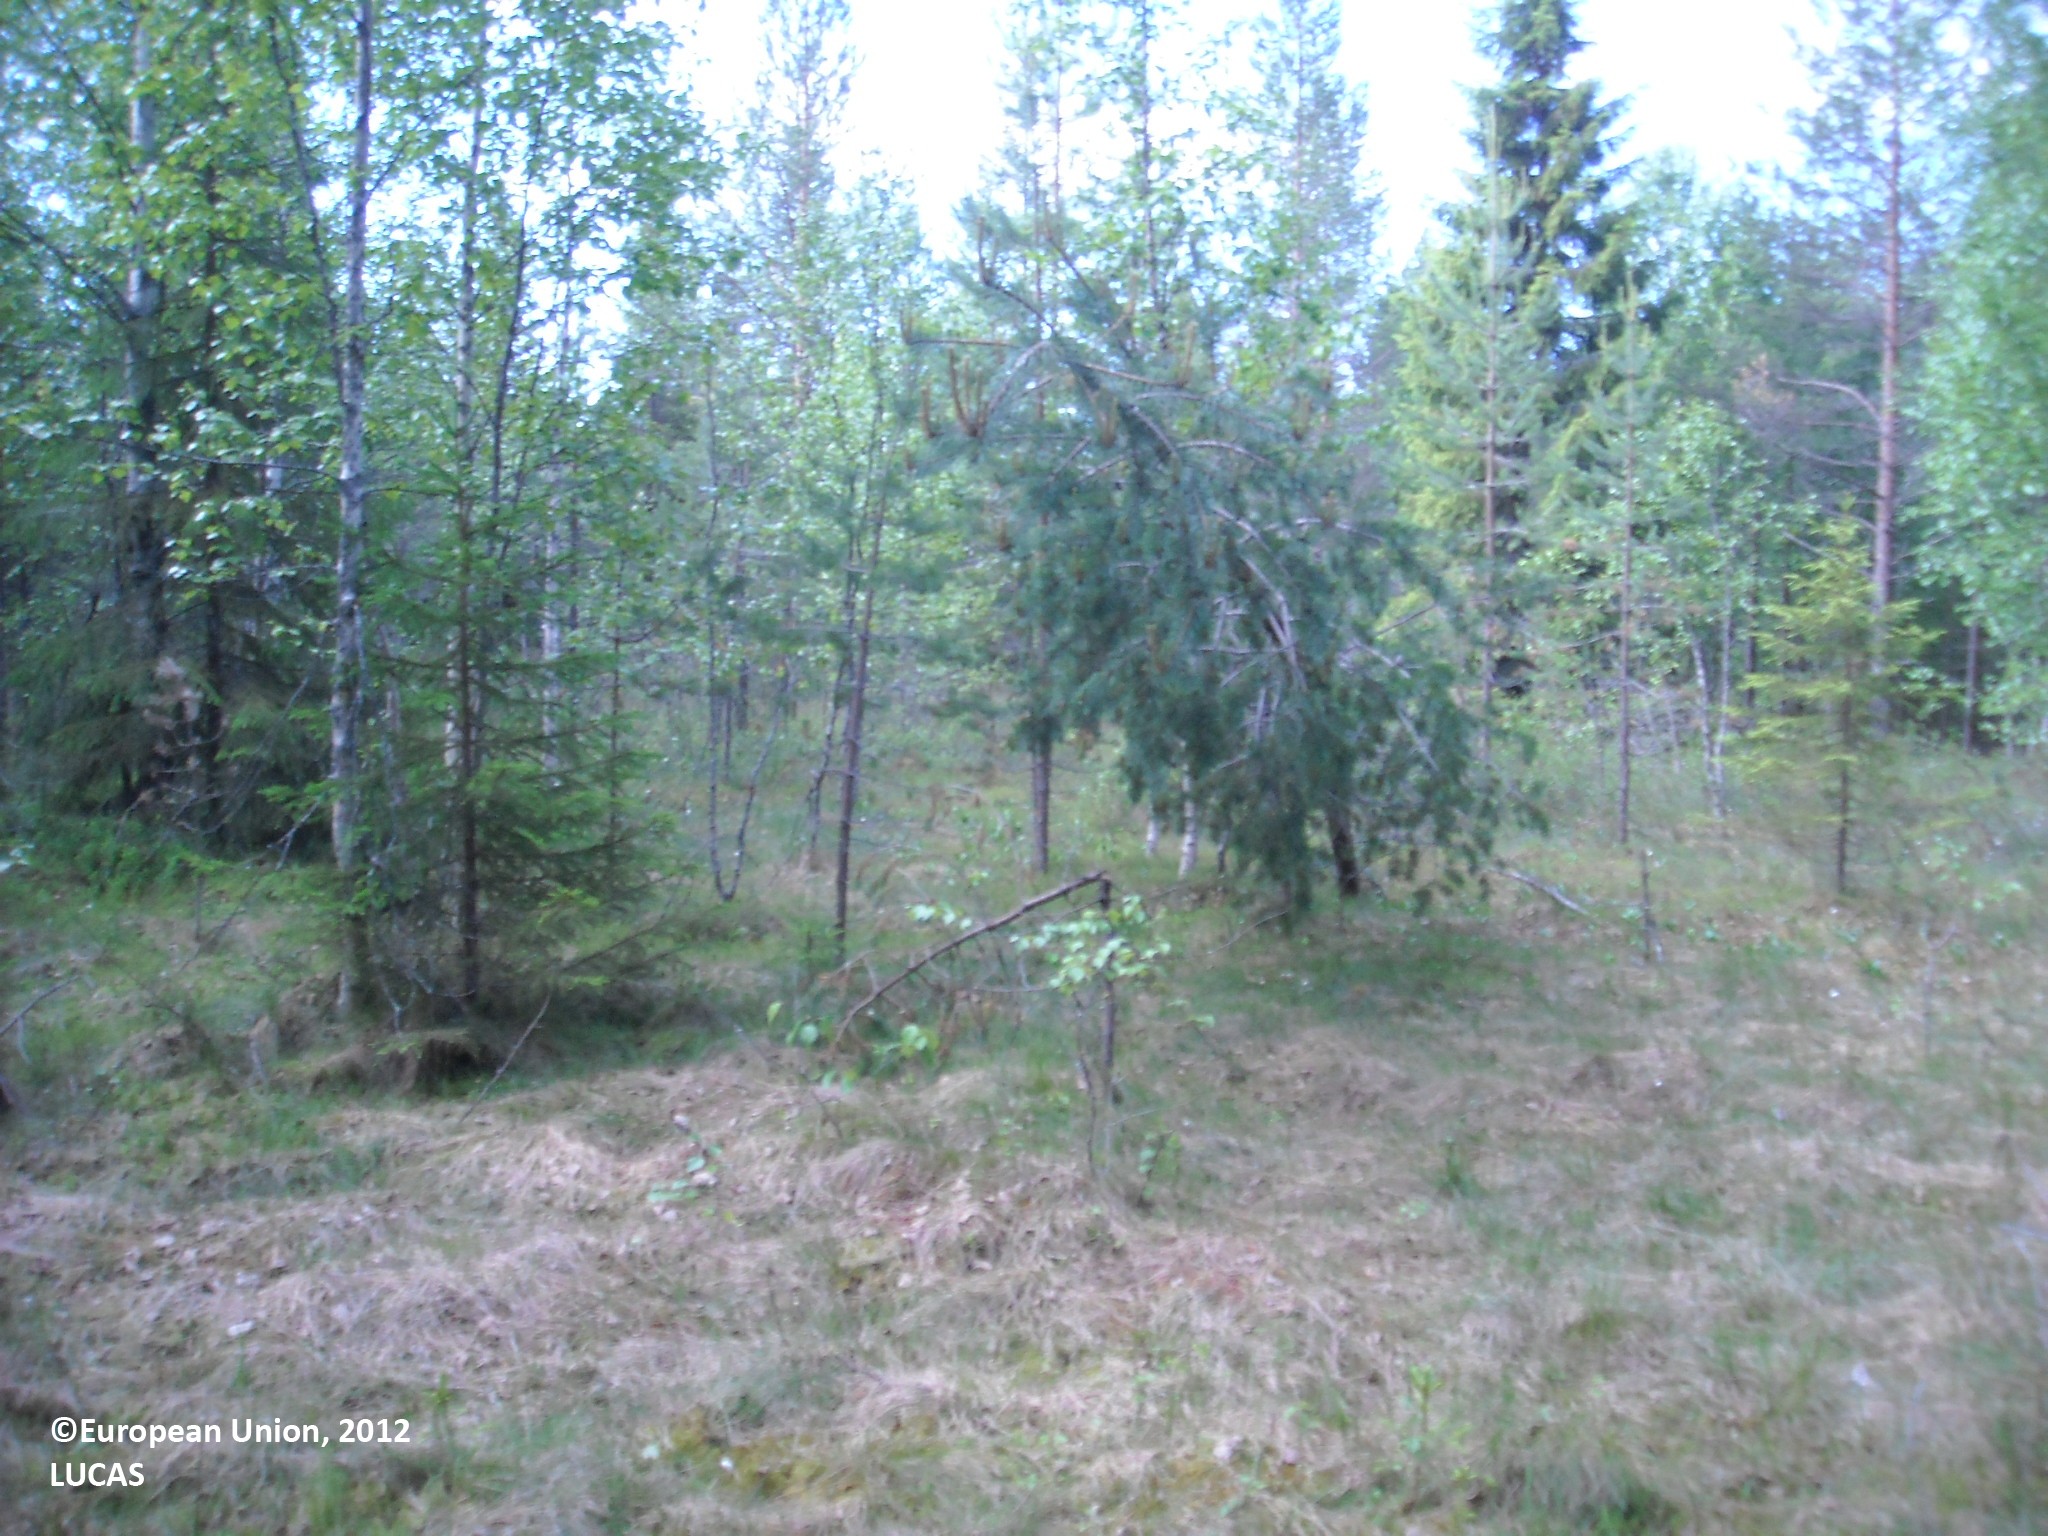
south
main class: Woodland
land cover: Other mixed woodland
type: mire and swamp forests
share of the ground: 50 - 75 %
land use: Forestry
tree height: > 5 m
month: July
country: FI
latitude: 64.6769
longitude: 27.6850
